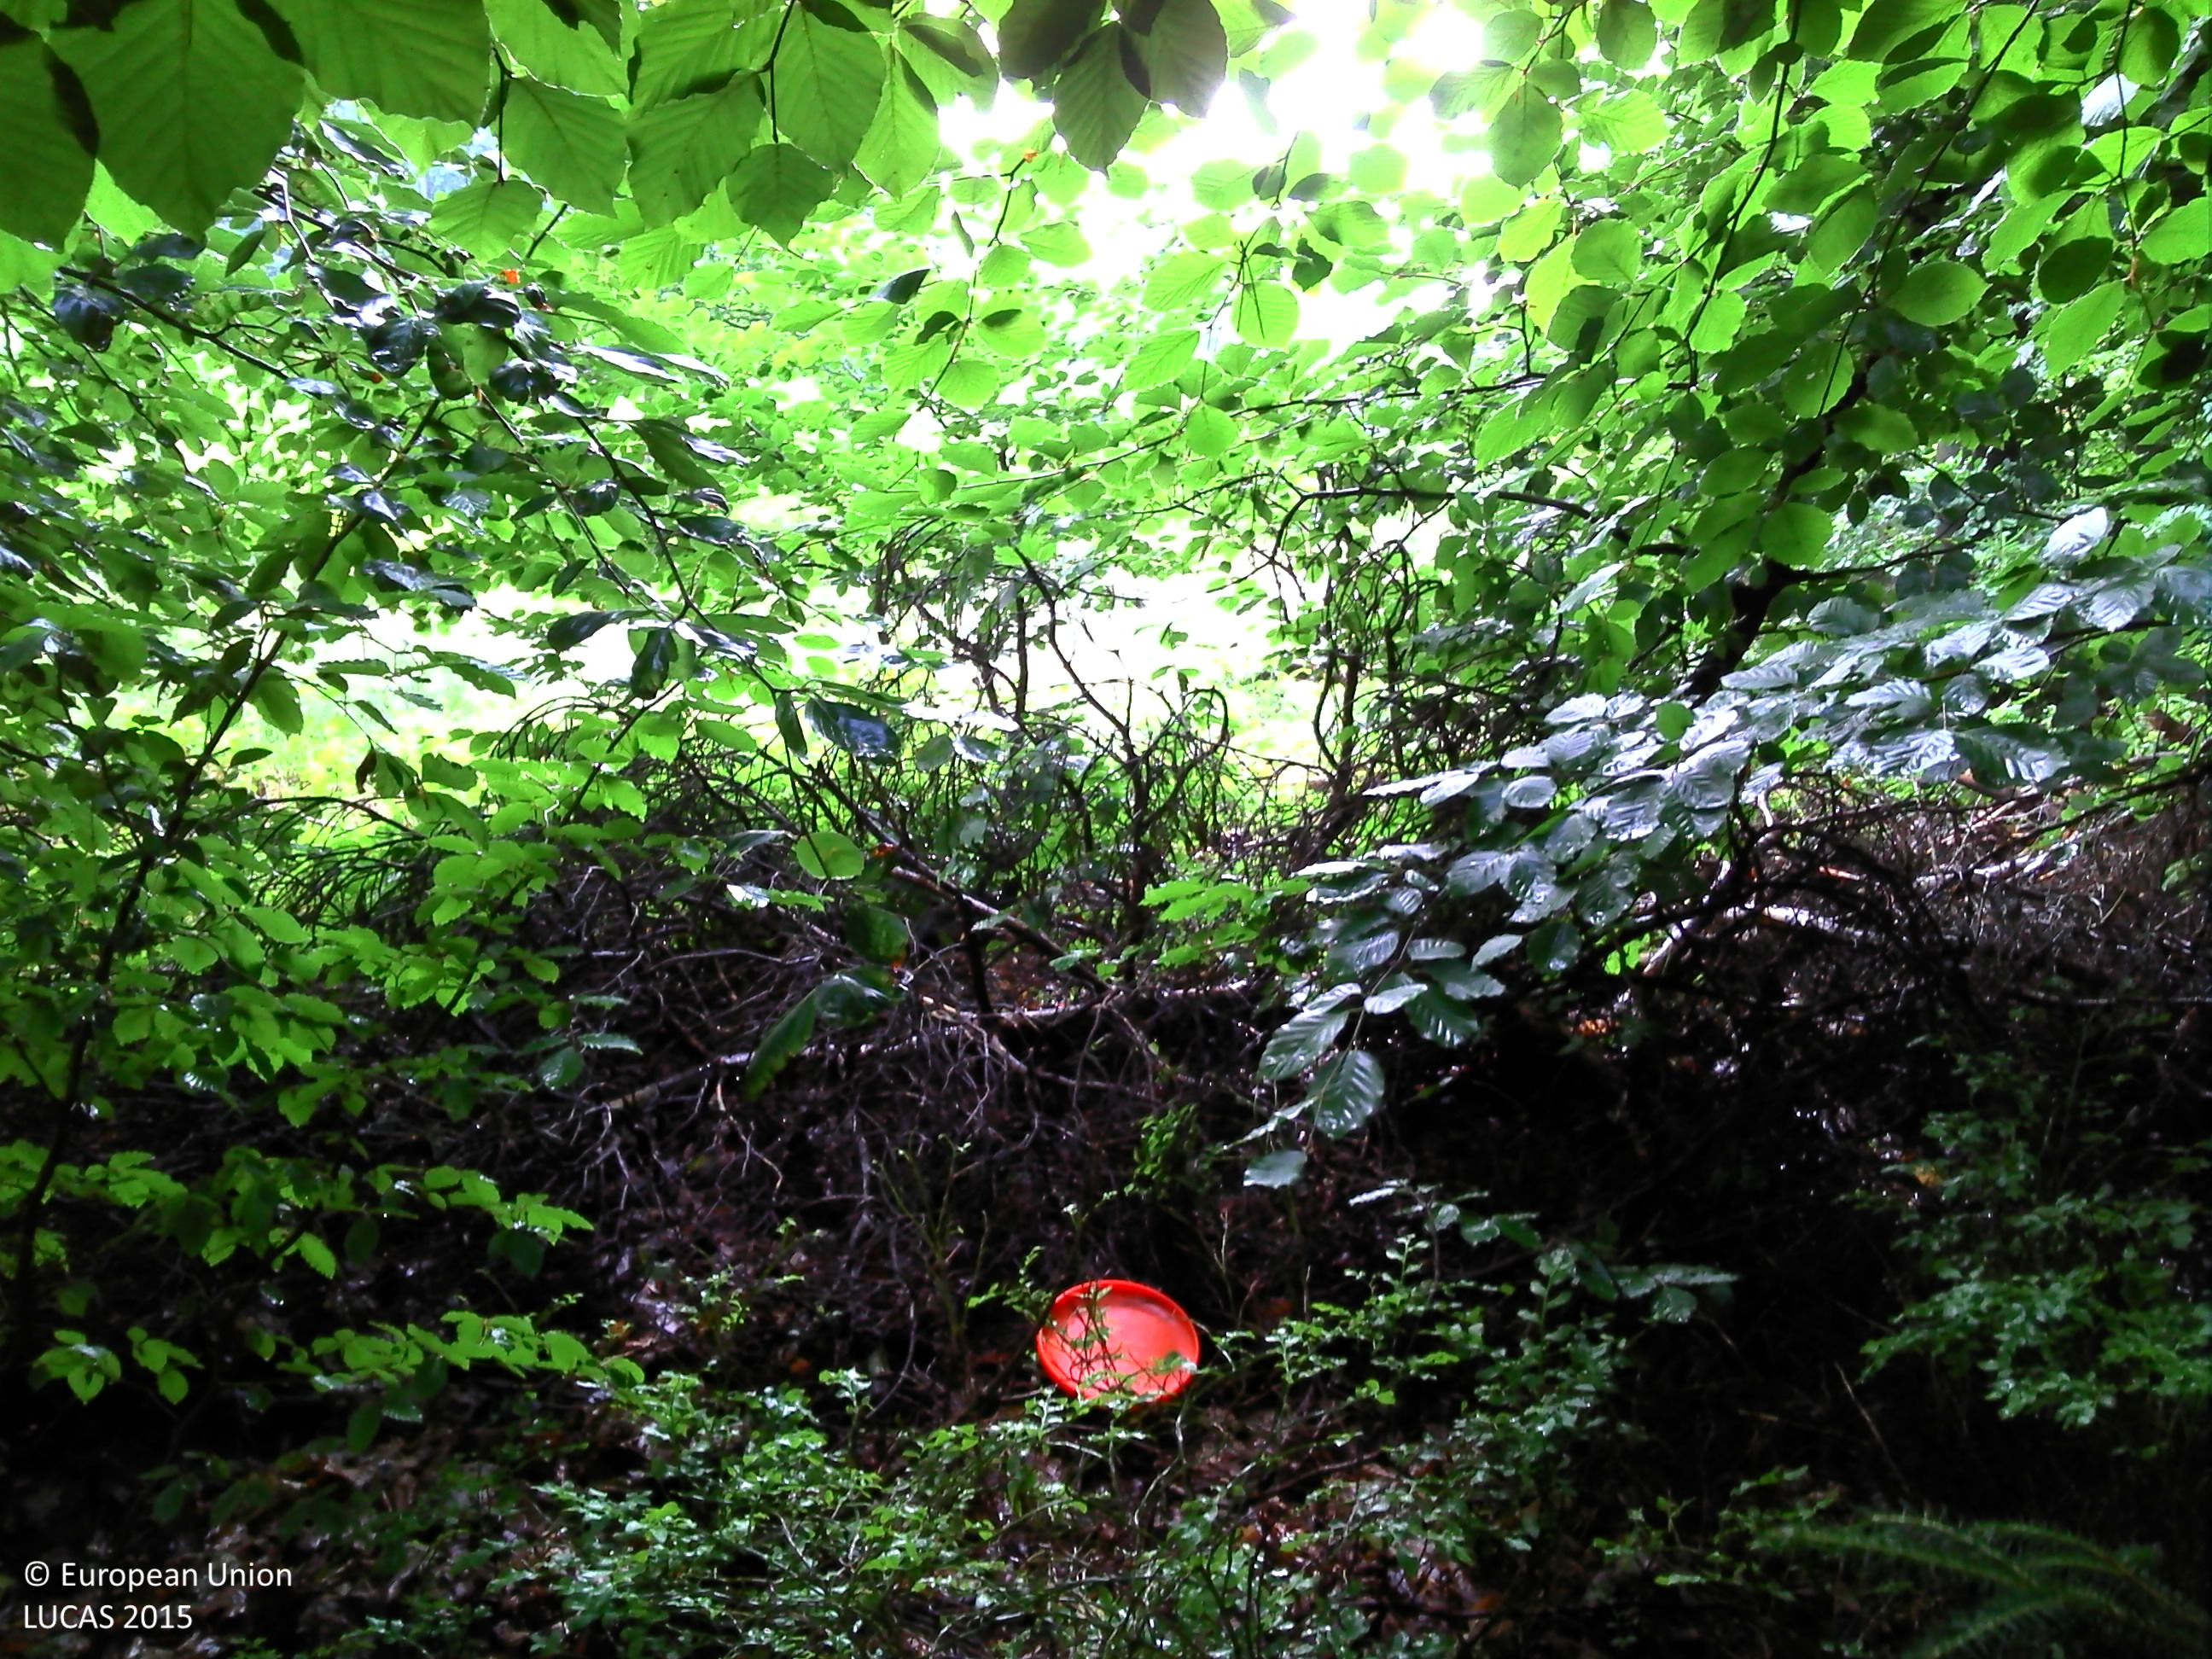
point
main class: Woodland
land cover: Pine dominated mixed woodland
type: hemiboreal forest and nemoral coniferous forest and mixed broadleaved-coniferous forest
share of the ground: > 75 %
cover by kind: broadleaved forest trees 50 %, coniferous forest trees 40 %, herbaceous plants 10 %
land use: Forestry
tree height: > 5 m
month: July
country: BE
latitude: 50.5055
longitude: 5.8675
